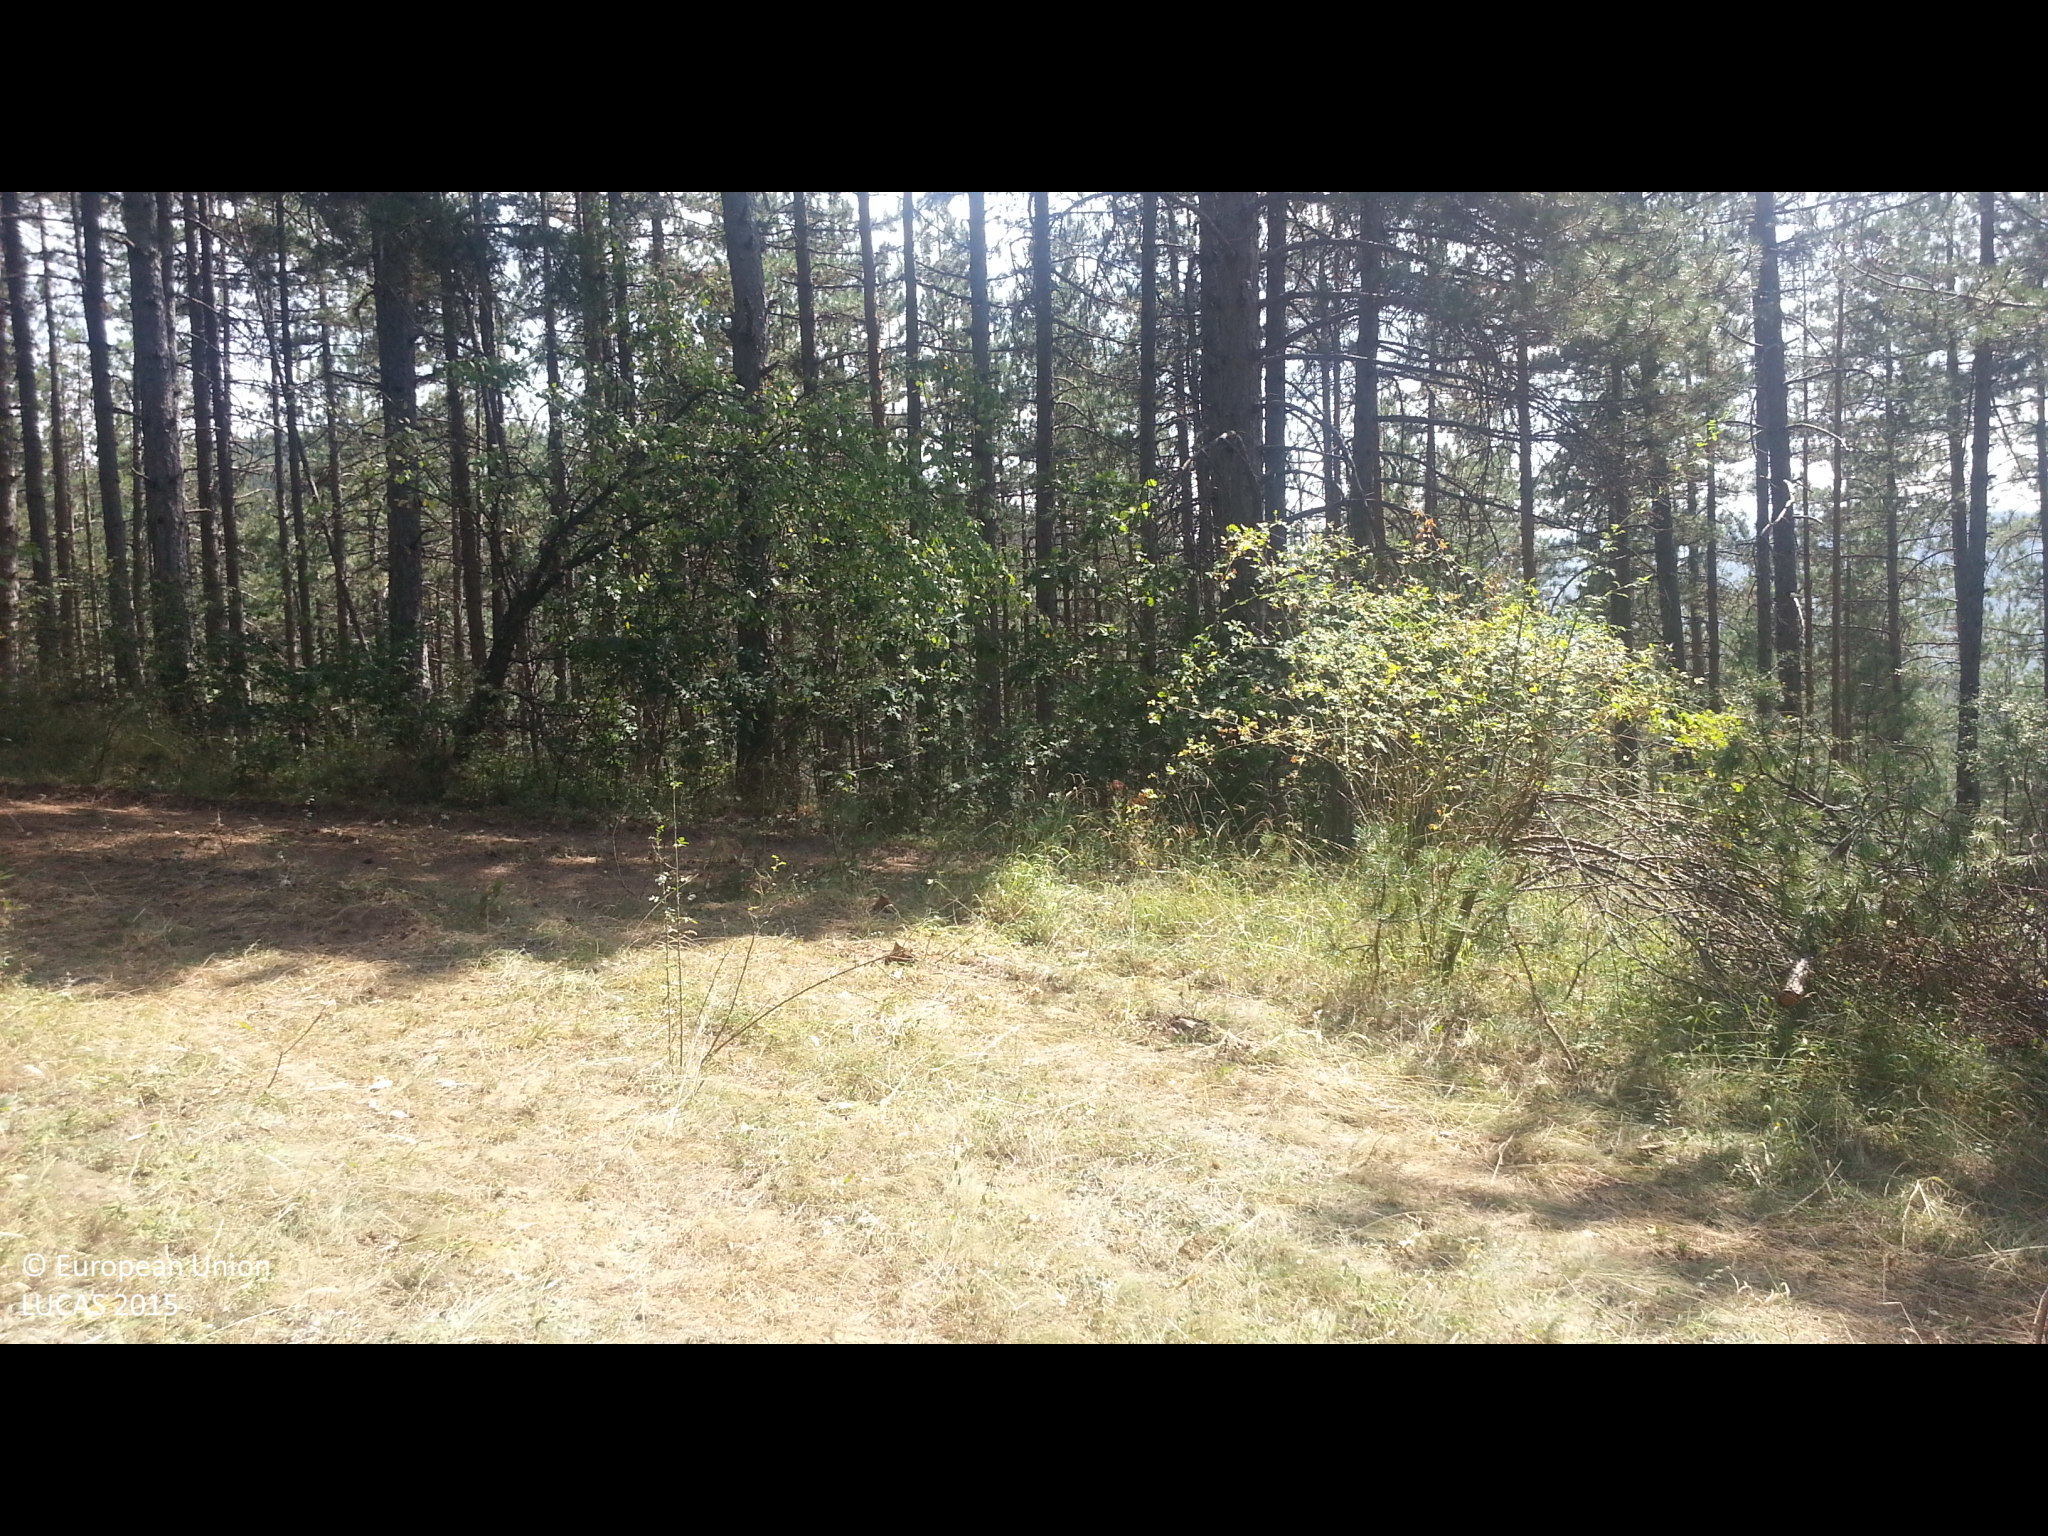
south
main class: Woodland
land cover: Pine dominated mixed woodland
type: hemiboreal forest and nemoral coniferous forest and mixed broadleaved-coniferous forest
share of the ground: > 75 %
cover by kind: coniferous forest trees 65 %, broadleaved forest trees 25 %, herbaceous plants 10 %
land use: Forestry
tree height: < 5 m
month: September
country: BG
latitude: 42.4294
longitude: 22.6023
